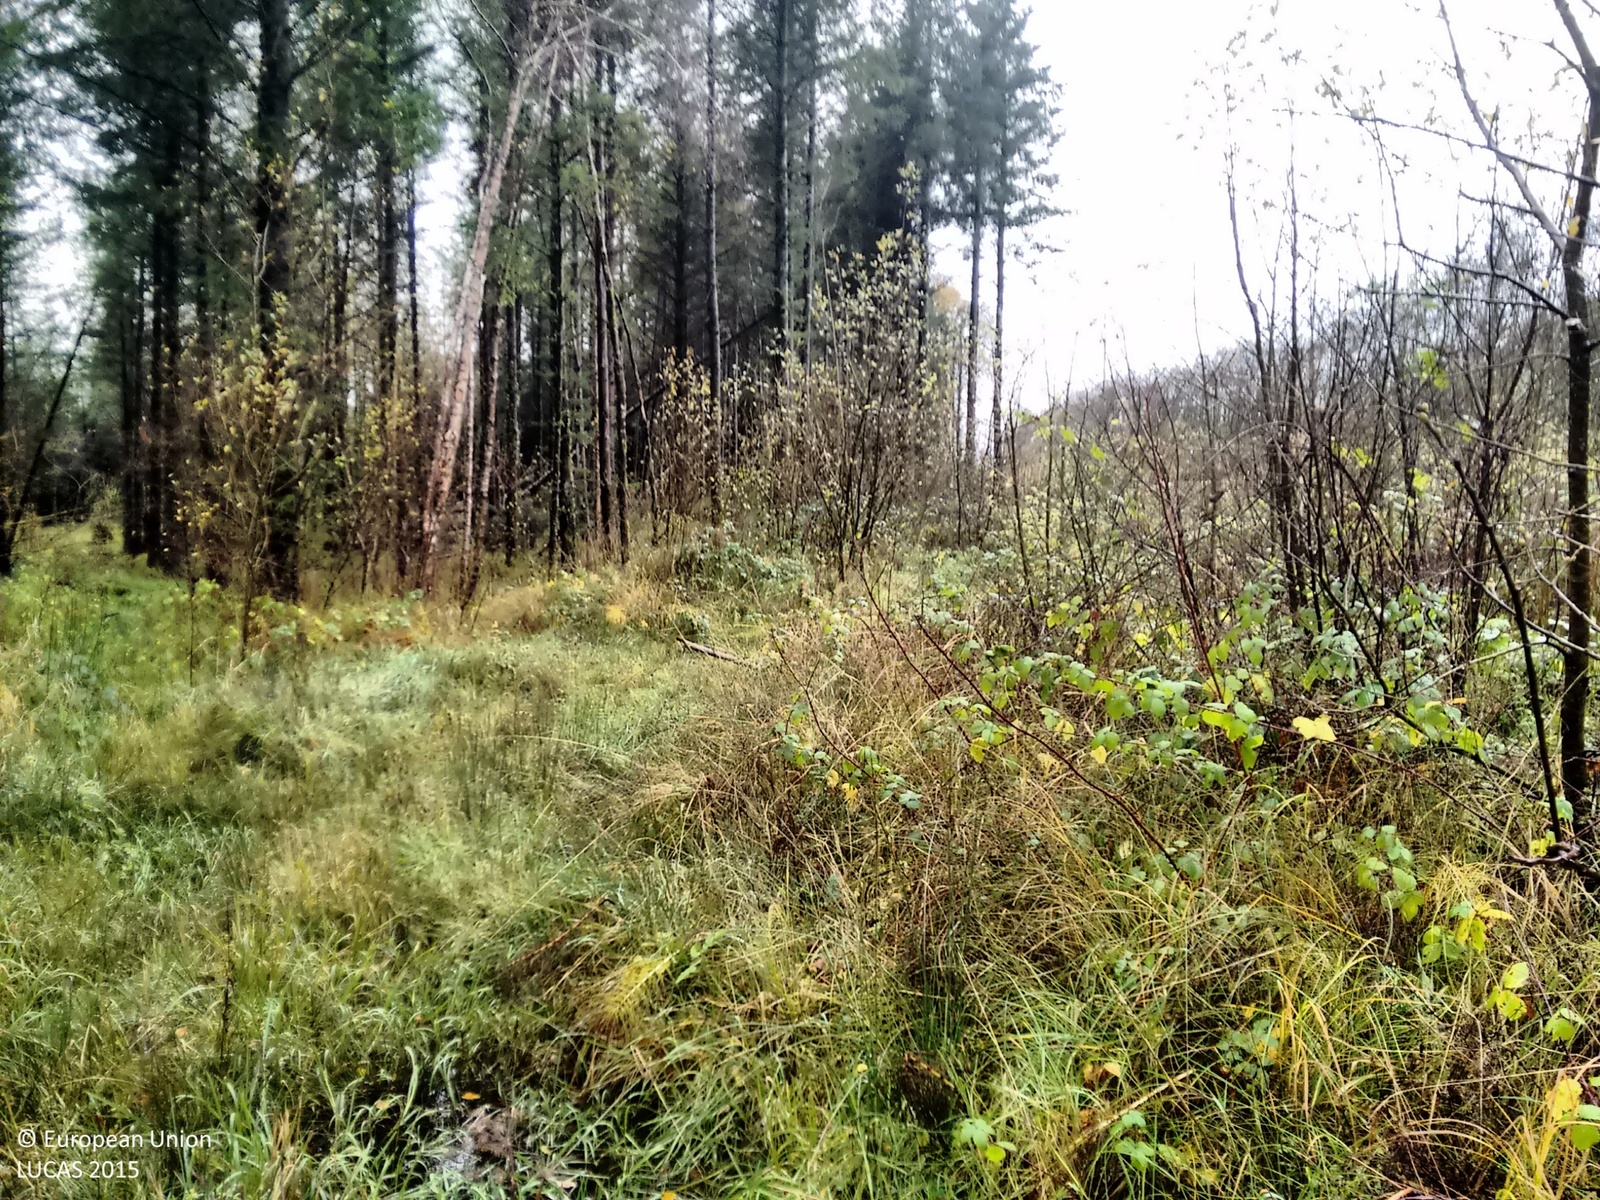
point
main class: Woodland
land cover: Pine dominated mixed woodland
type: exotic forest
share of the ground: > 75 %
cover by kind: coniferous forest trees 70 %, broadleaved forest trees 25 %, herbaceous plants 5 %
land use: Forestry
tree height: > 5 m
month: November
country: IE
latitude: 53.9357
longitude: -8.0116
